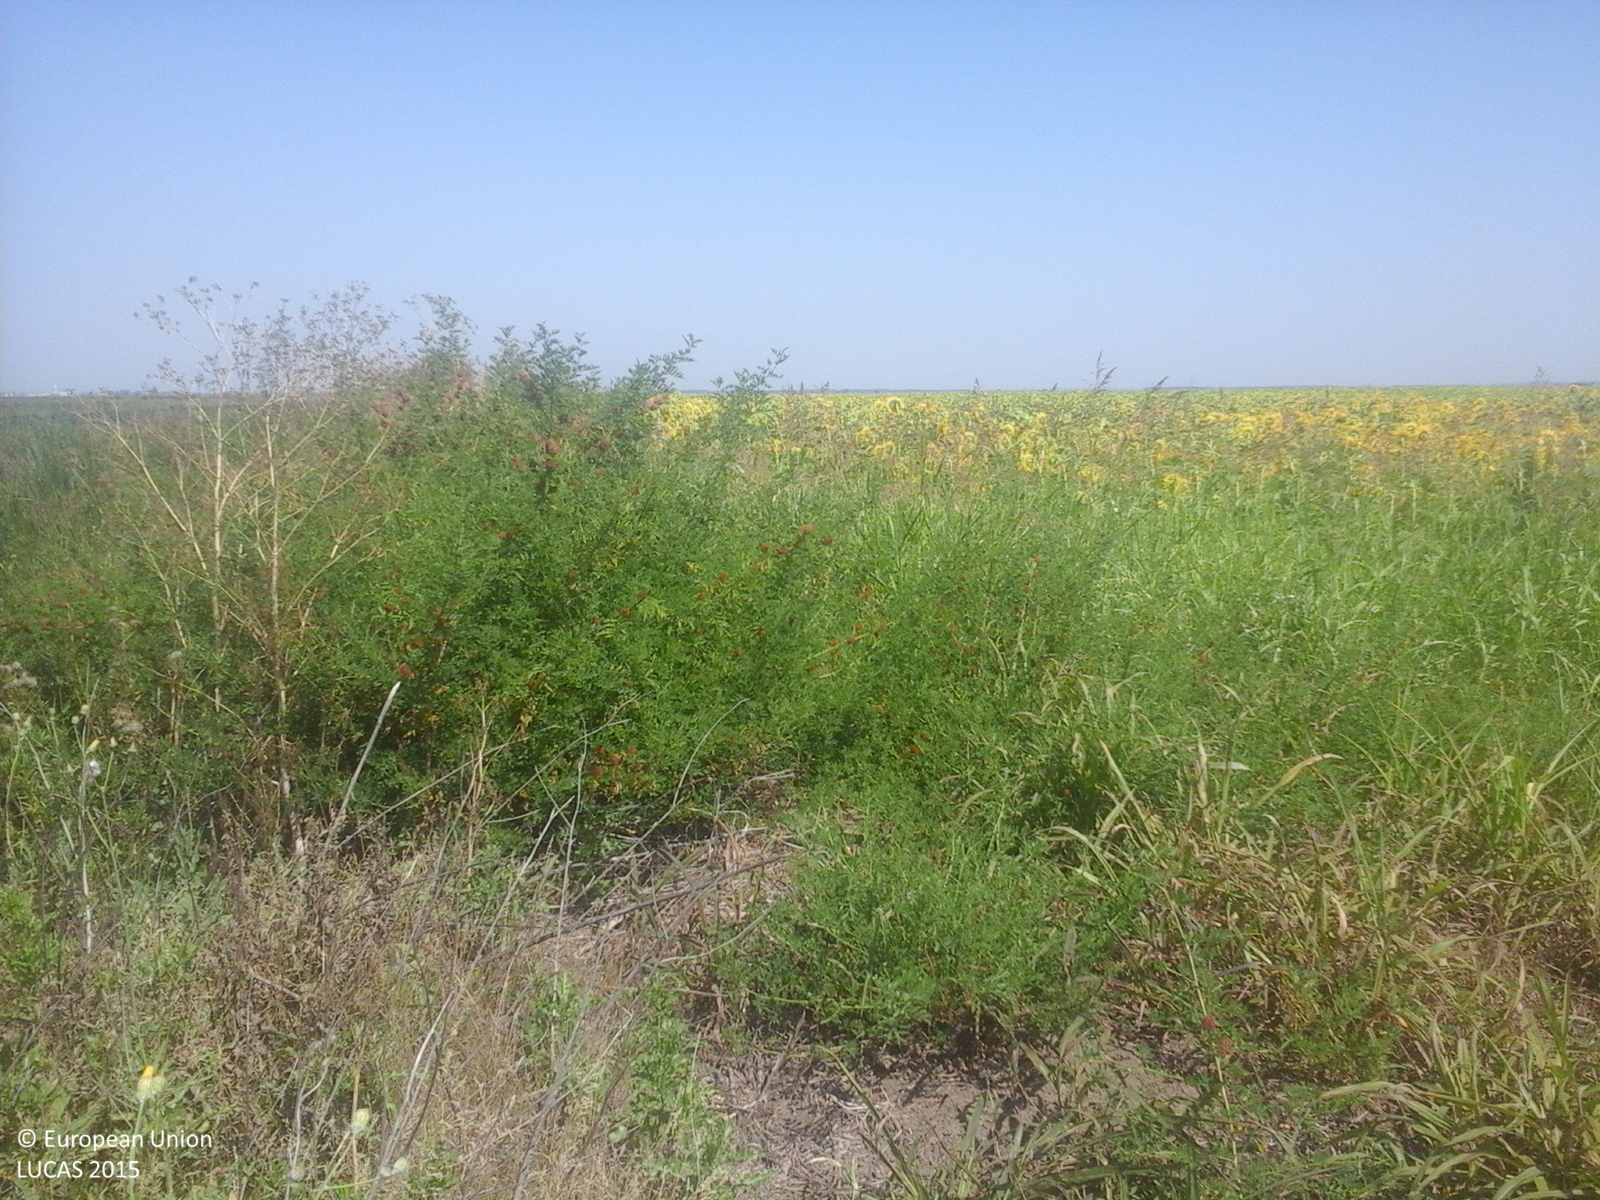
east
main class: Cropland
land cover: Soya
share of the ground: > 75 %
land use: Agriculture (excluding fallow land and kitchen gardens)
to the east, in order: Soya
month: July
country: RO
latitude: 44.1926
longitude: 27.1835
